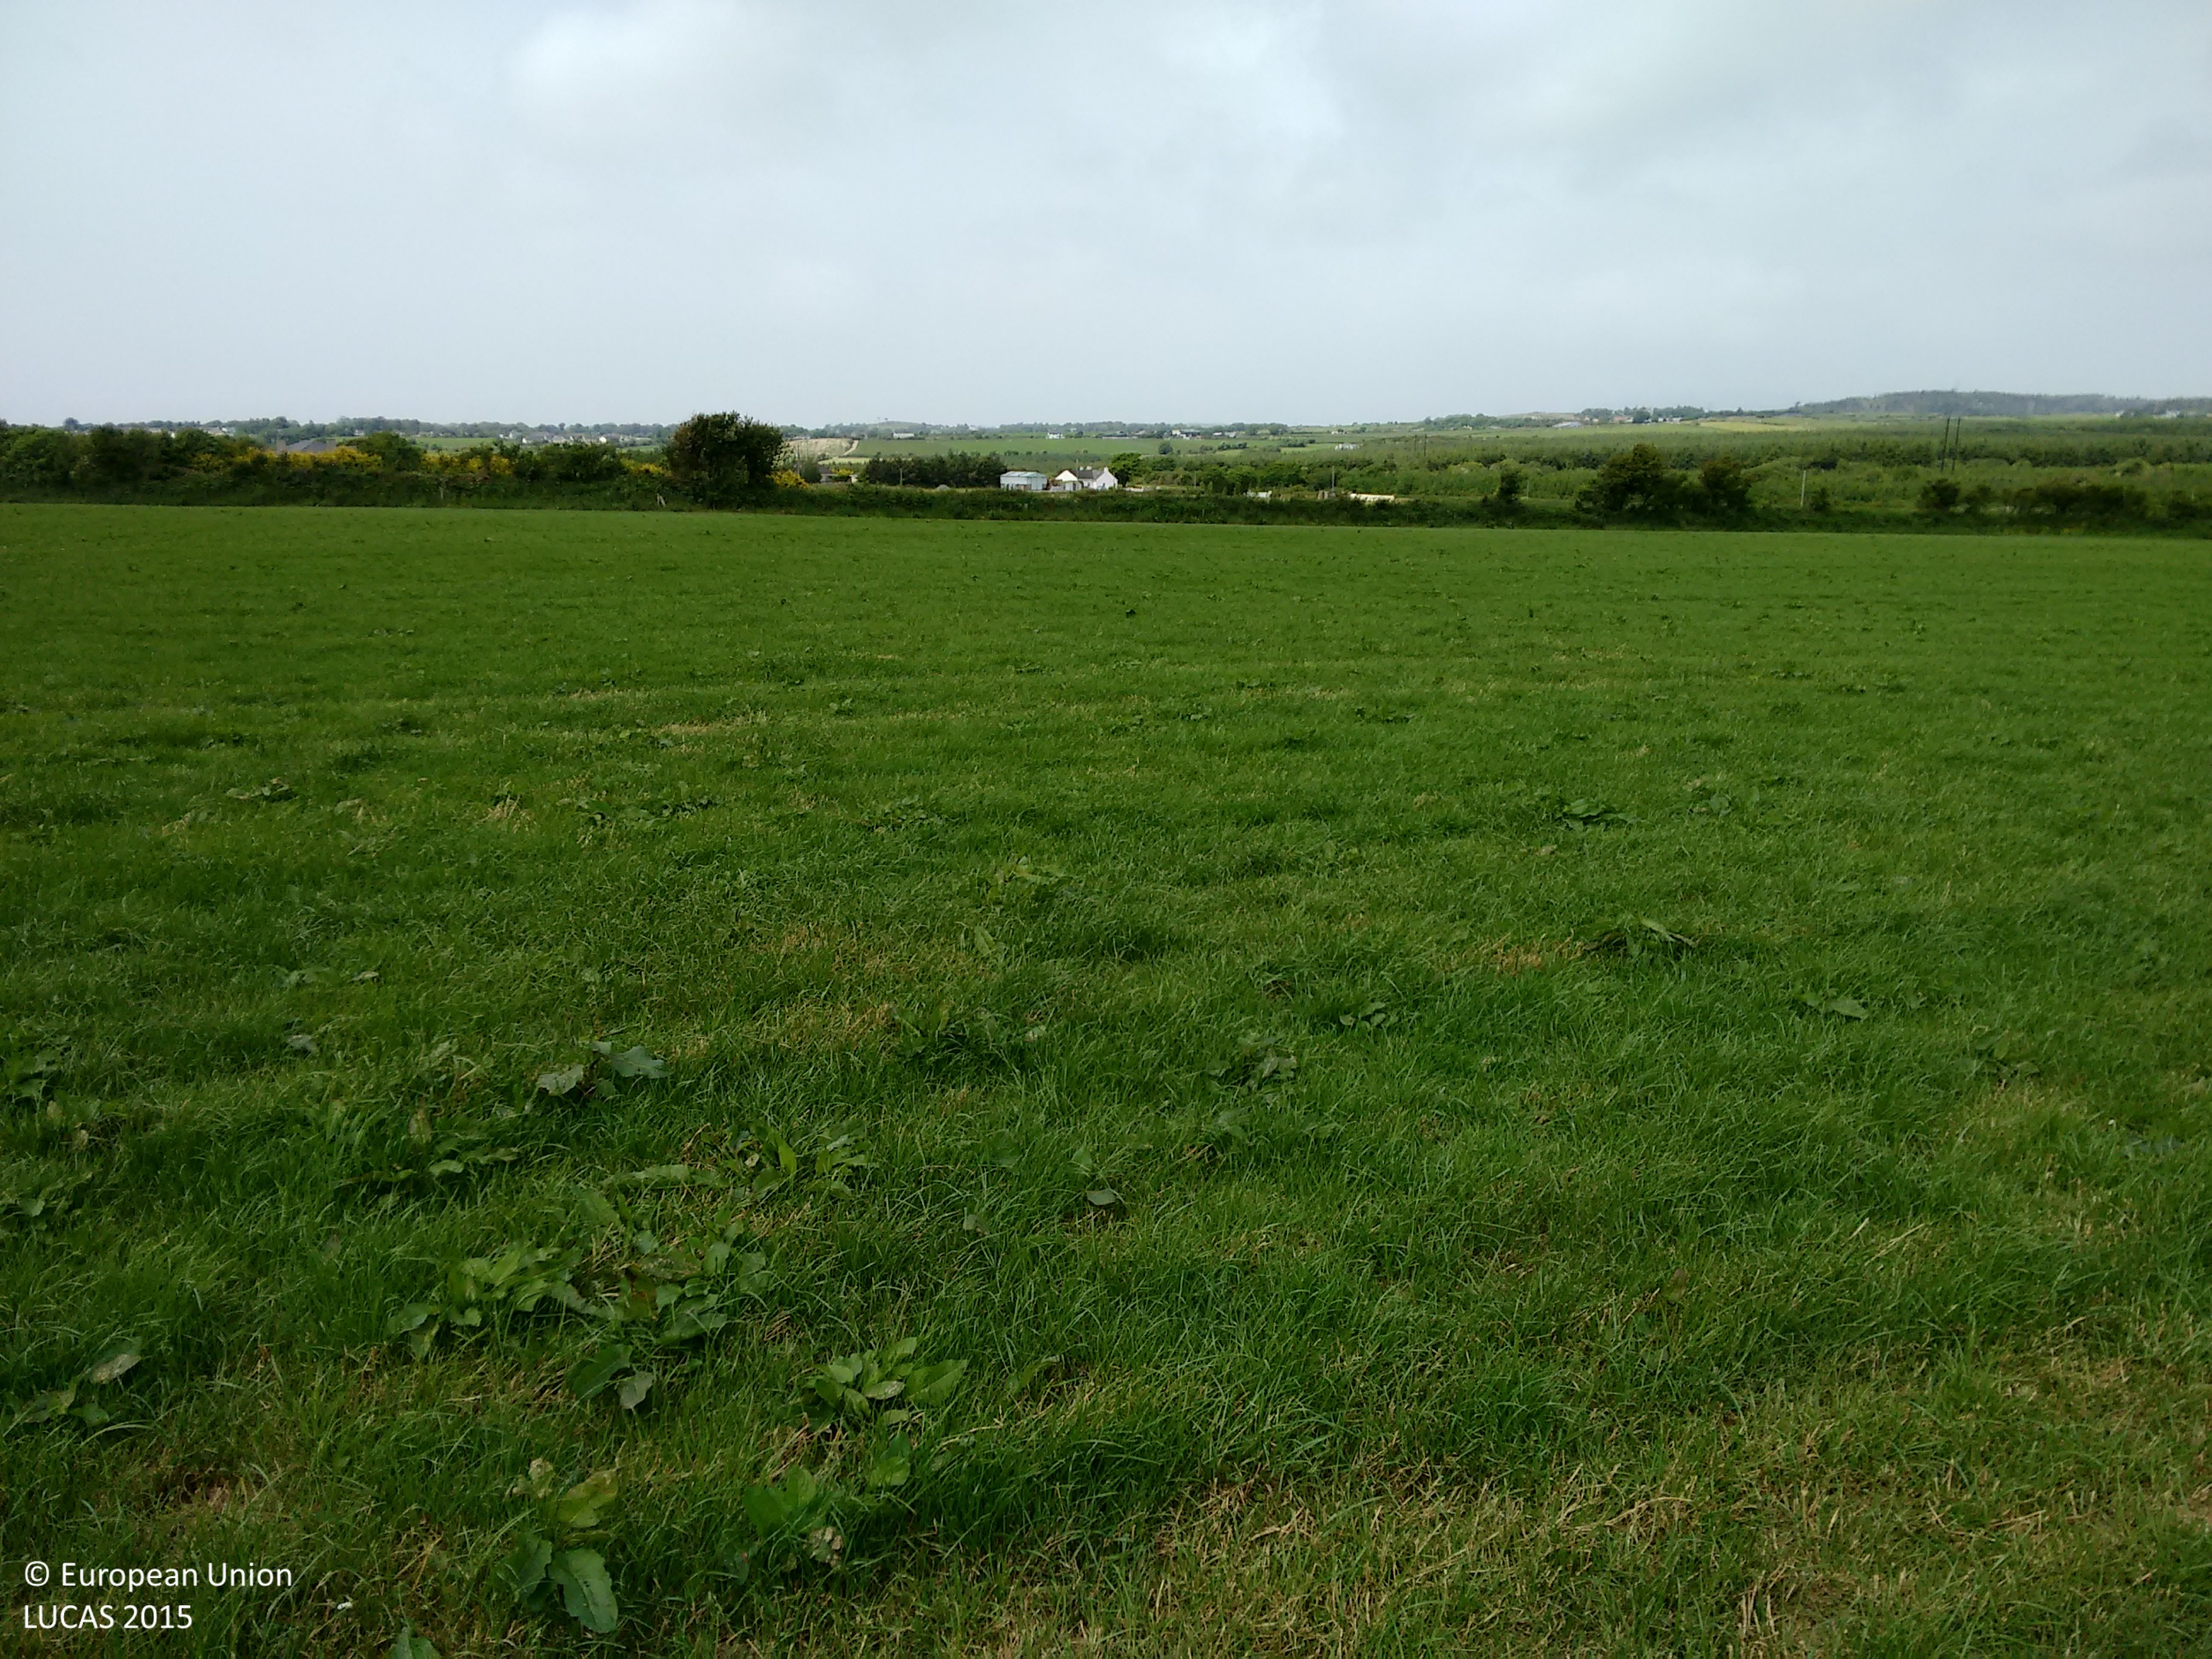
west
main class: Grassland
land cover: Grassland without tree/shrub cover
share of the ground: > 75 %
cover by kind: herbaceous plants 100 %
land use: Agriculture (excluding fallow land and kitchen gardens)
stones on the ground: < 10 %
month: June
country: IE
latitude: 52.1783
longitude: -7.3069
